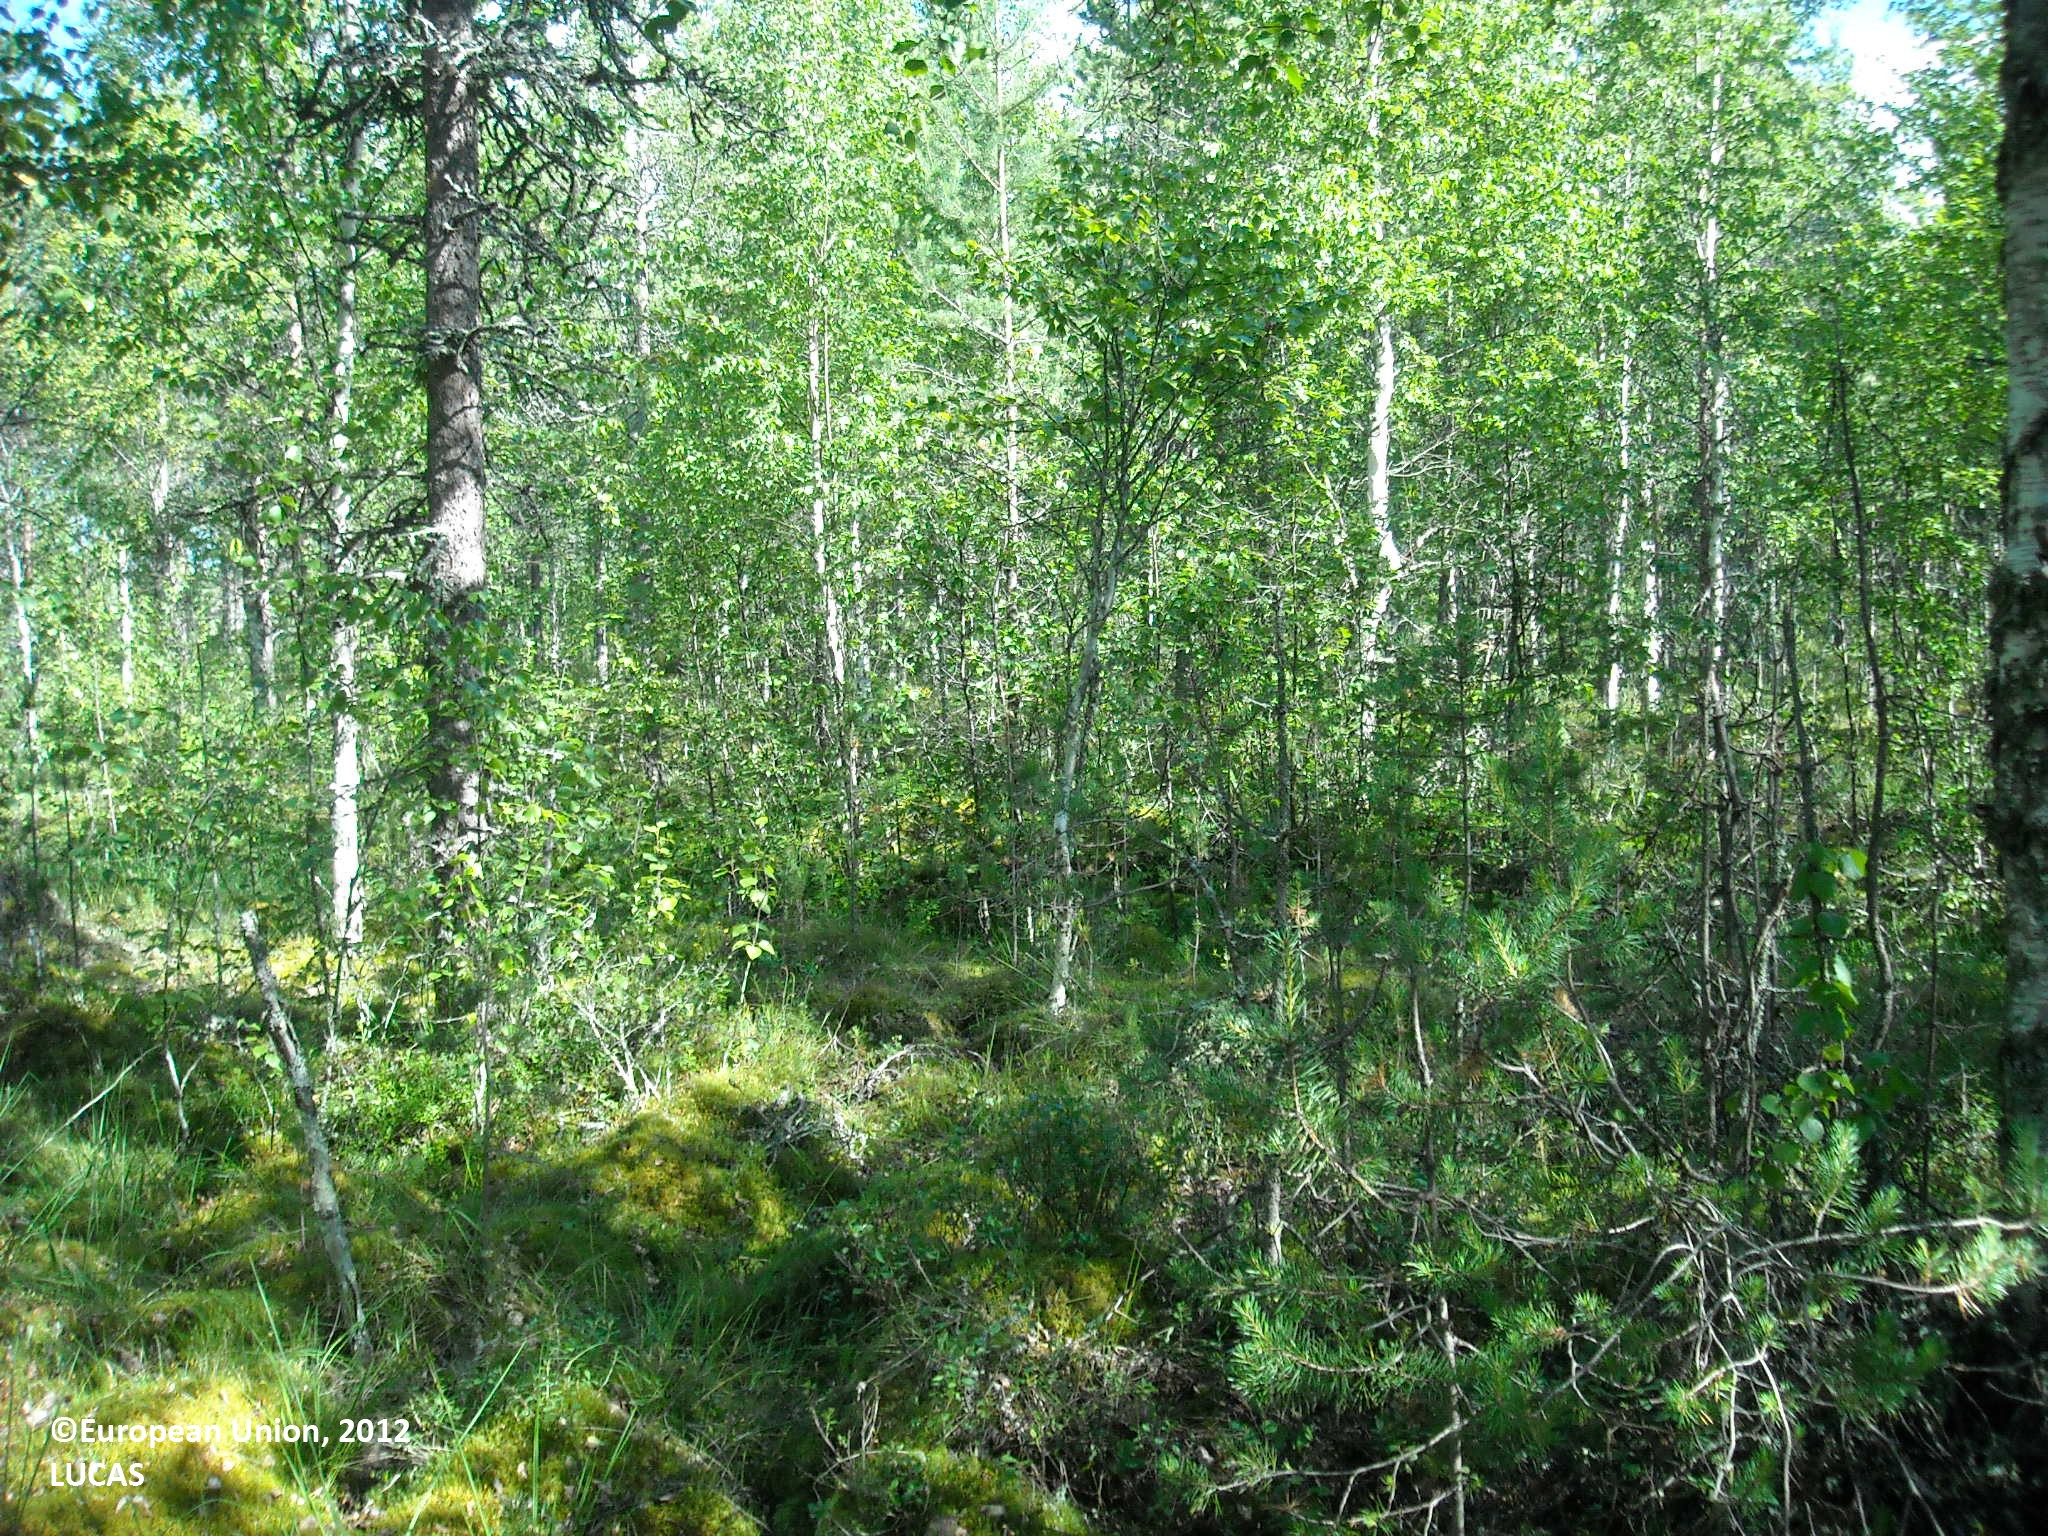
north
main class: Woodland
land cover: Pine dominated mixed woodland
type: mire and swamp forests
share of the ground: > 75 %
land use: Forestry
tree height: > 5 m
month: July
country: FI
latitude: 65.0695
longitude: 27.5066
